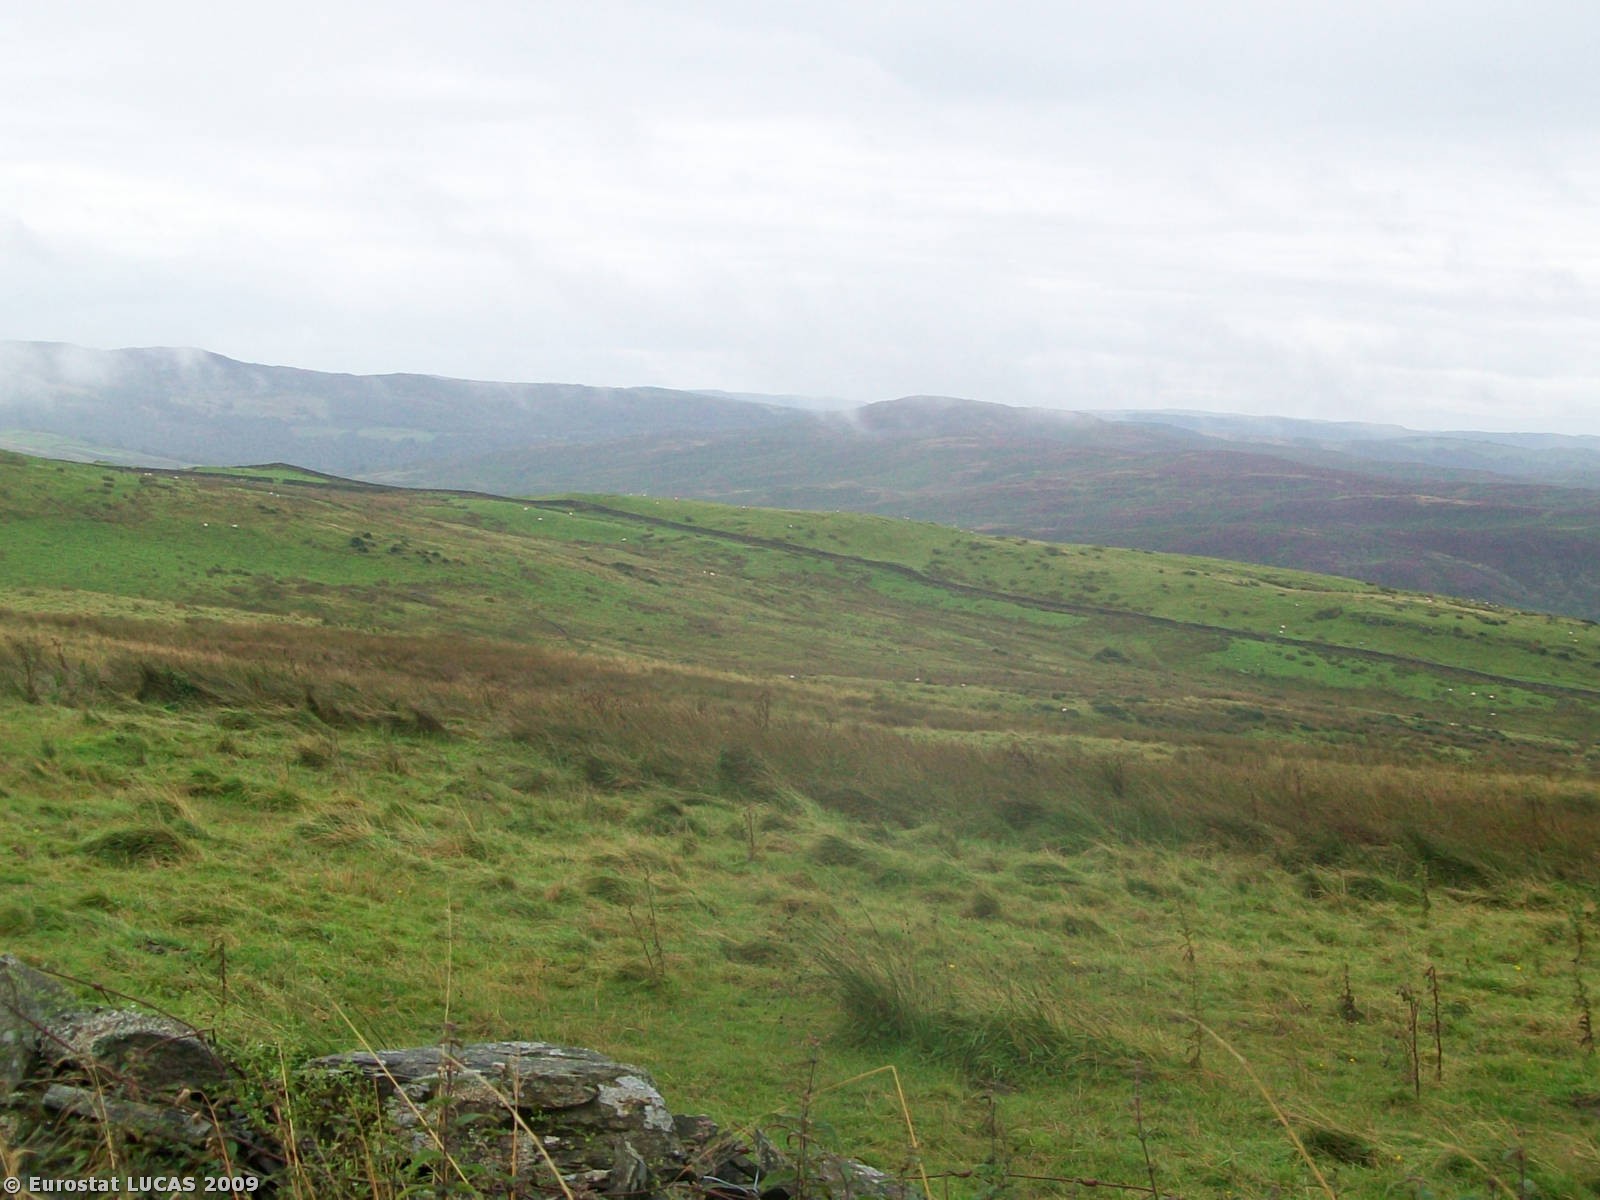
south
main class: Woodland
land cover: Coniferous woodland
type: plantations and self-sown exotic forest
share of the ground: > 75 %
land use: Forestry
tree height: > 5 m
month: August
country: GB
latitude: 54.3382
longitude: -3.1648
